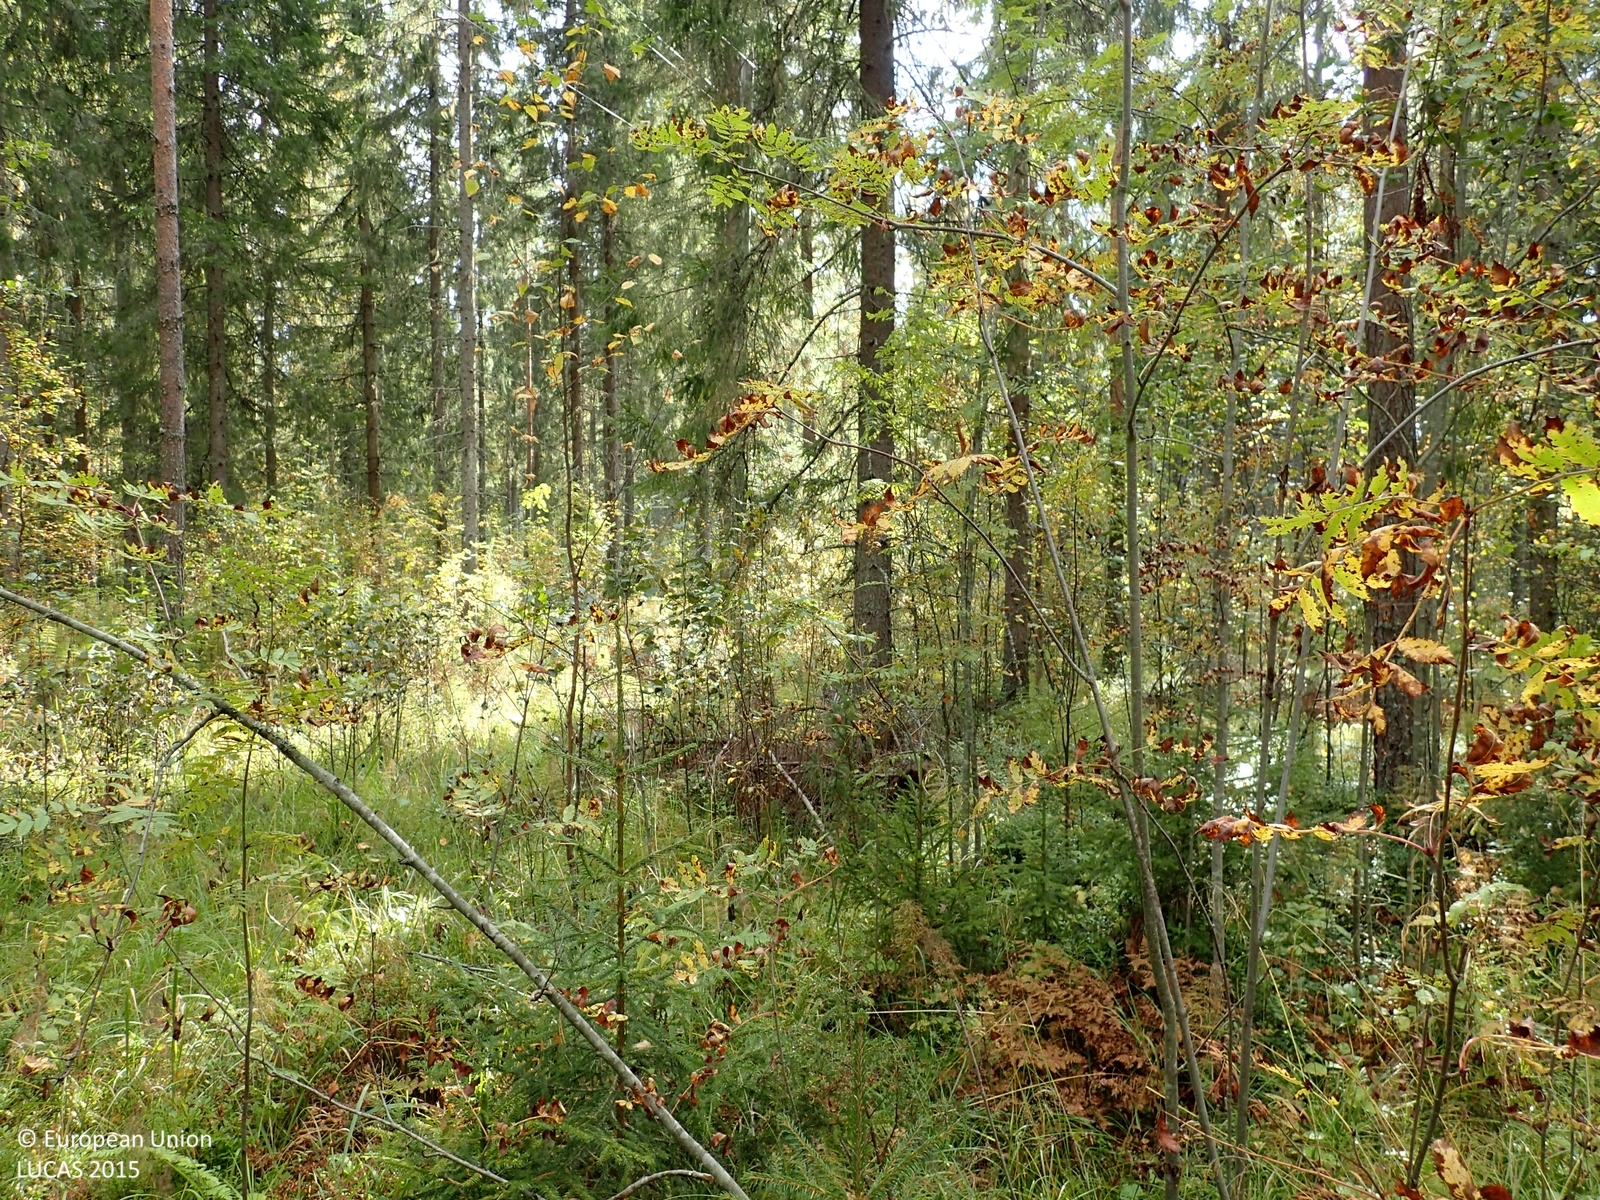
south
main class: Woodland
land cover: Pine dominated mixed woodland
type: boreal forest
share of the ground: > 75 %
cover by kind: coniferous forest trees 55 %, broadleaved forest trees 20 %, herbaceous plants 15 %, shrubs 10 %
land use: Forestry
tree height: > 5 m
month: September
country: FI
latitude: 63.0362
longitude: 25.3439
